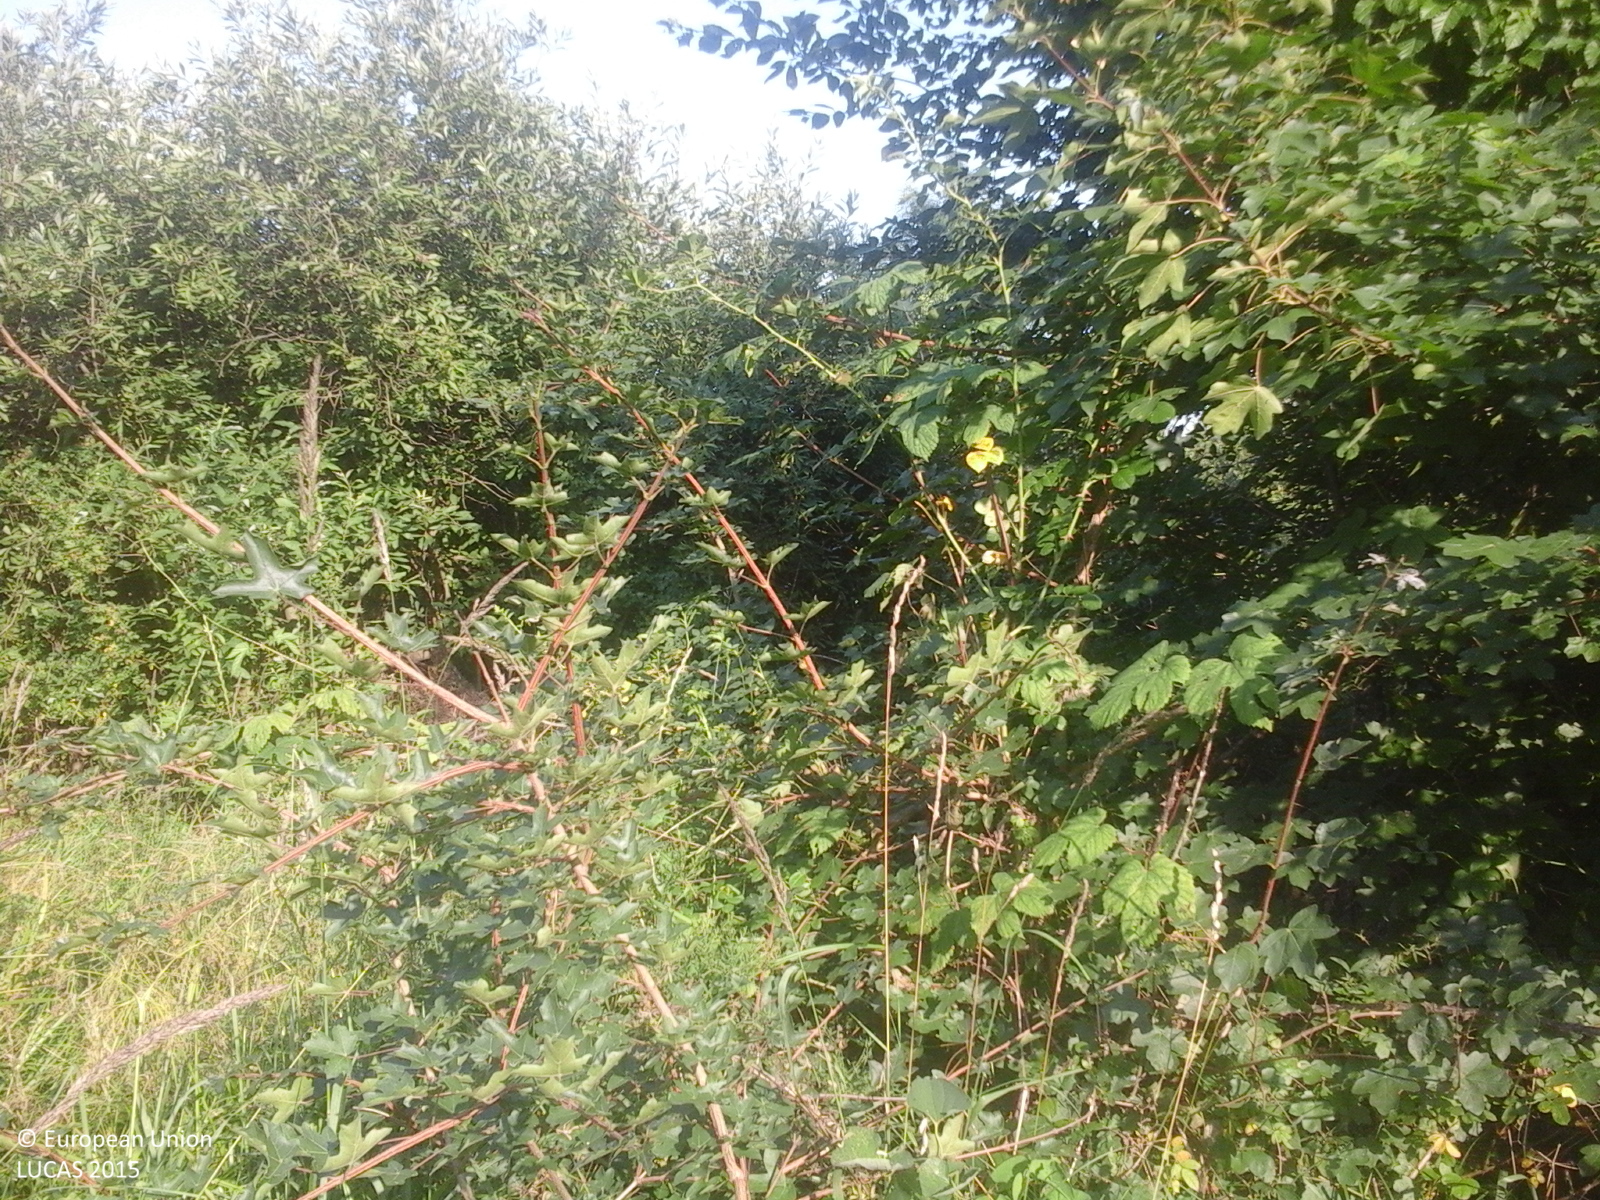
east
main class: Grassland
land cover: Grassland with sparse tree/shrub cover
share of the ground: > 75 %
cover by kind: herbaceous plants 85 %, shrubs 10 %, broadleaved forest trees 5 %
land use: Semi-natural and natural areas not in use
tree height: > 5 m
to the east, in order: Grassland with sparse tree/shrub cover; Broadleaved woodland; Tracks; Common wheat; Maize
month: July
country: RO
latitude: 44.5224
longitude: 24.7080
